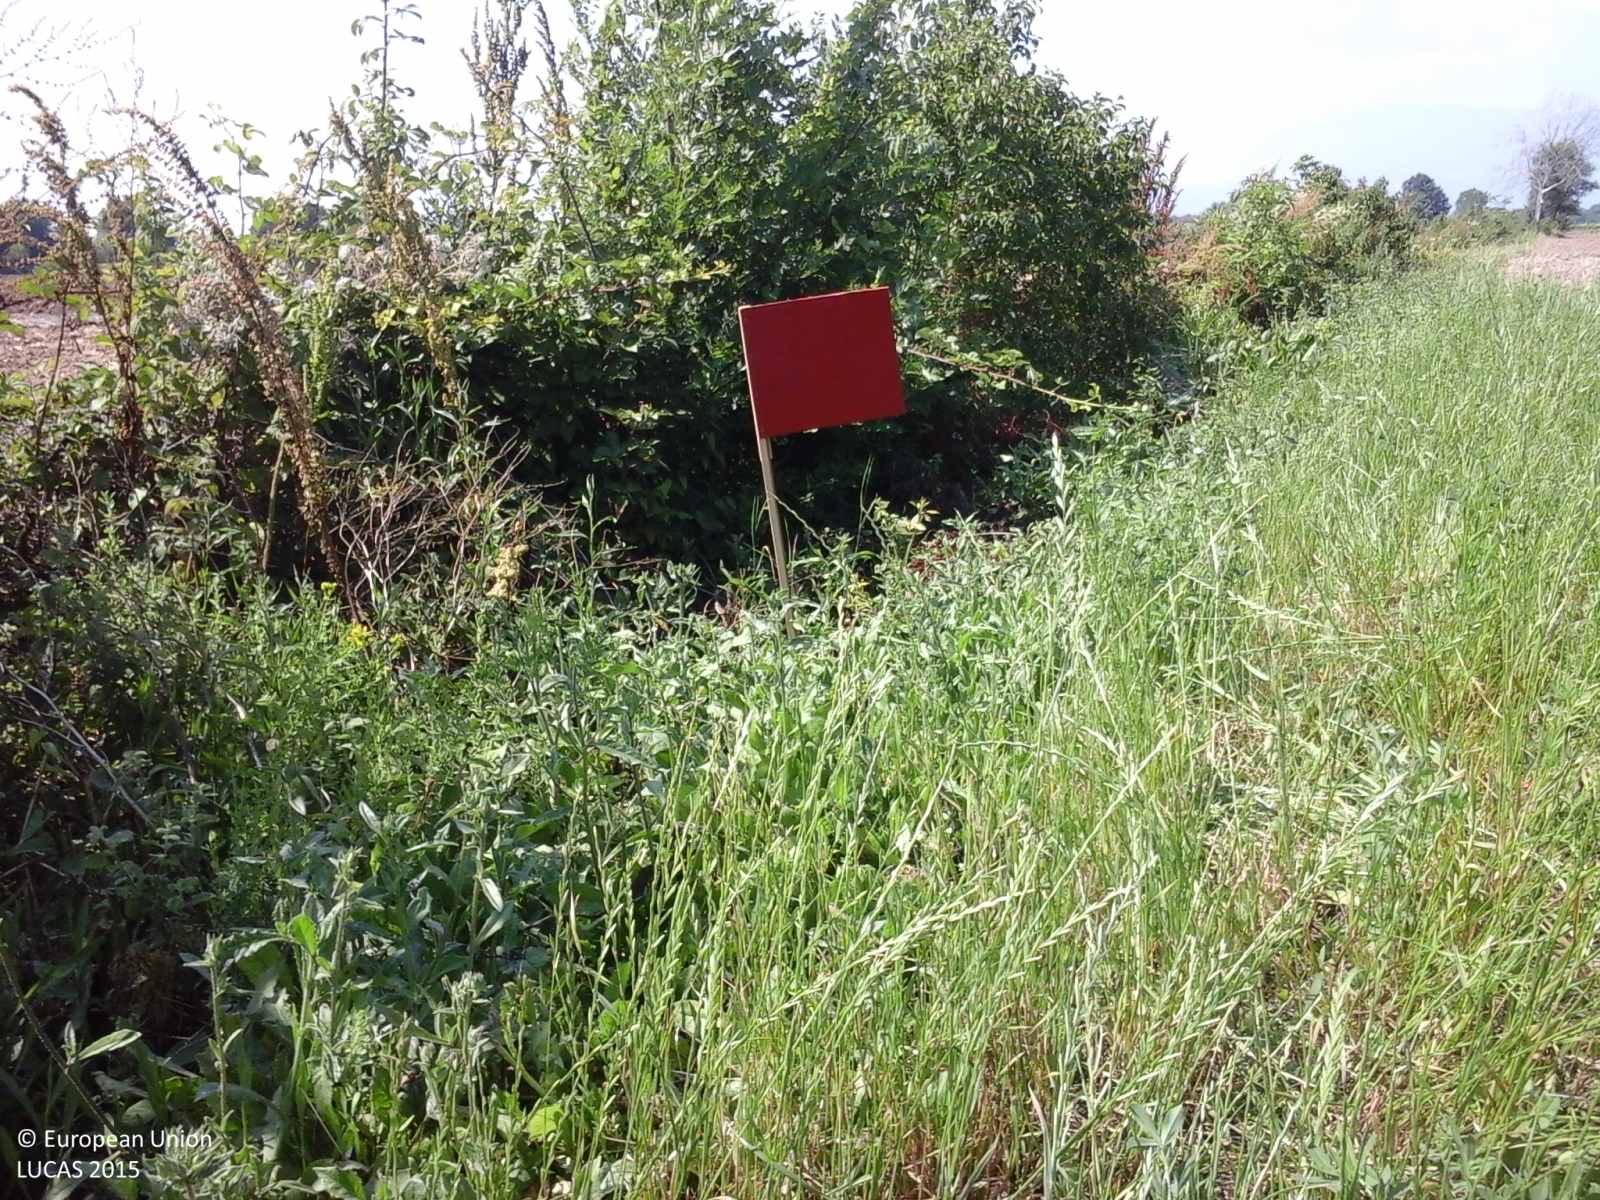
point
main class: Cropland
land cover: Lucerne
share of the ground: > 75 %
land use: Agriculture (excluding fallow land and kitchen gardens)
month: June
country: IT
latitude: 40.5364
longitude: 15.0436
